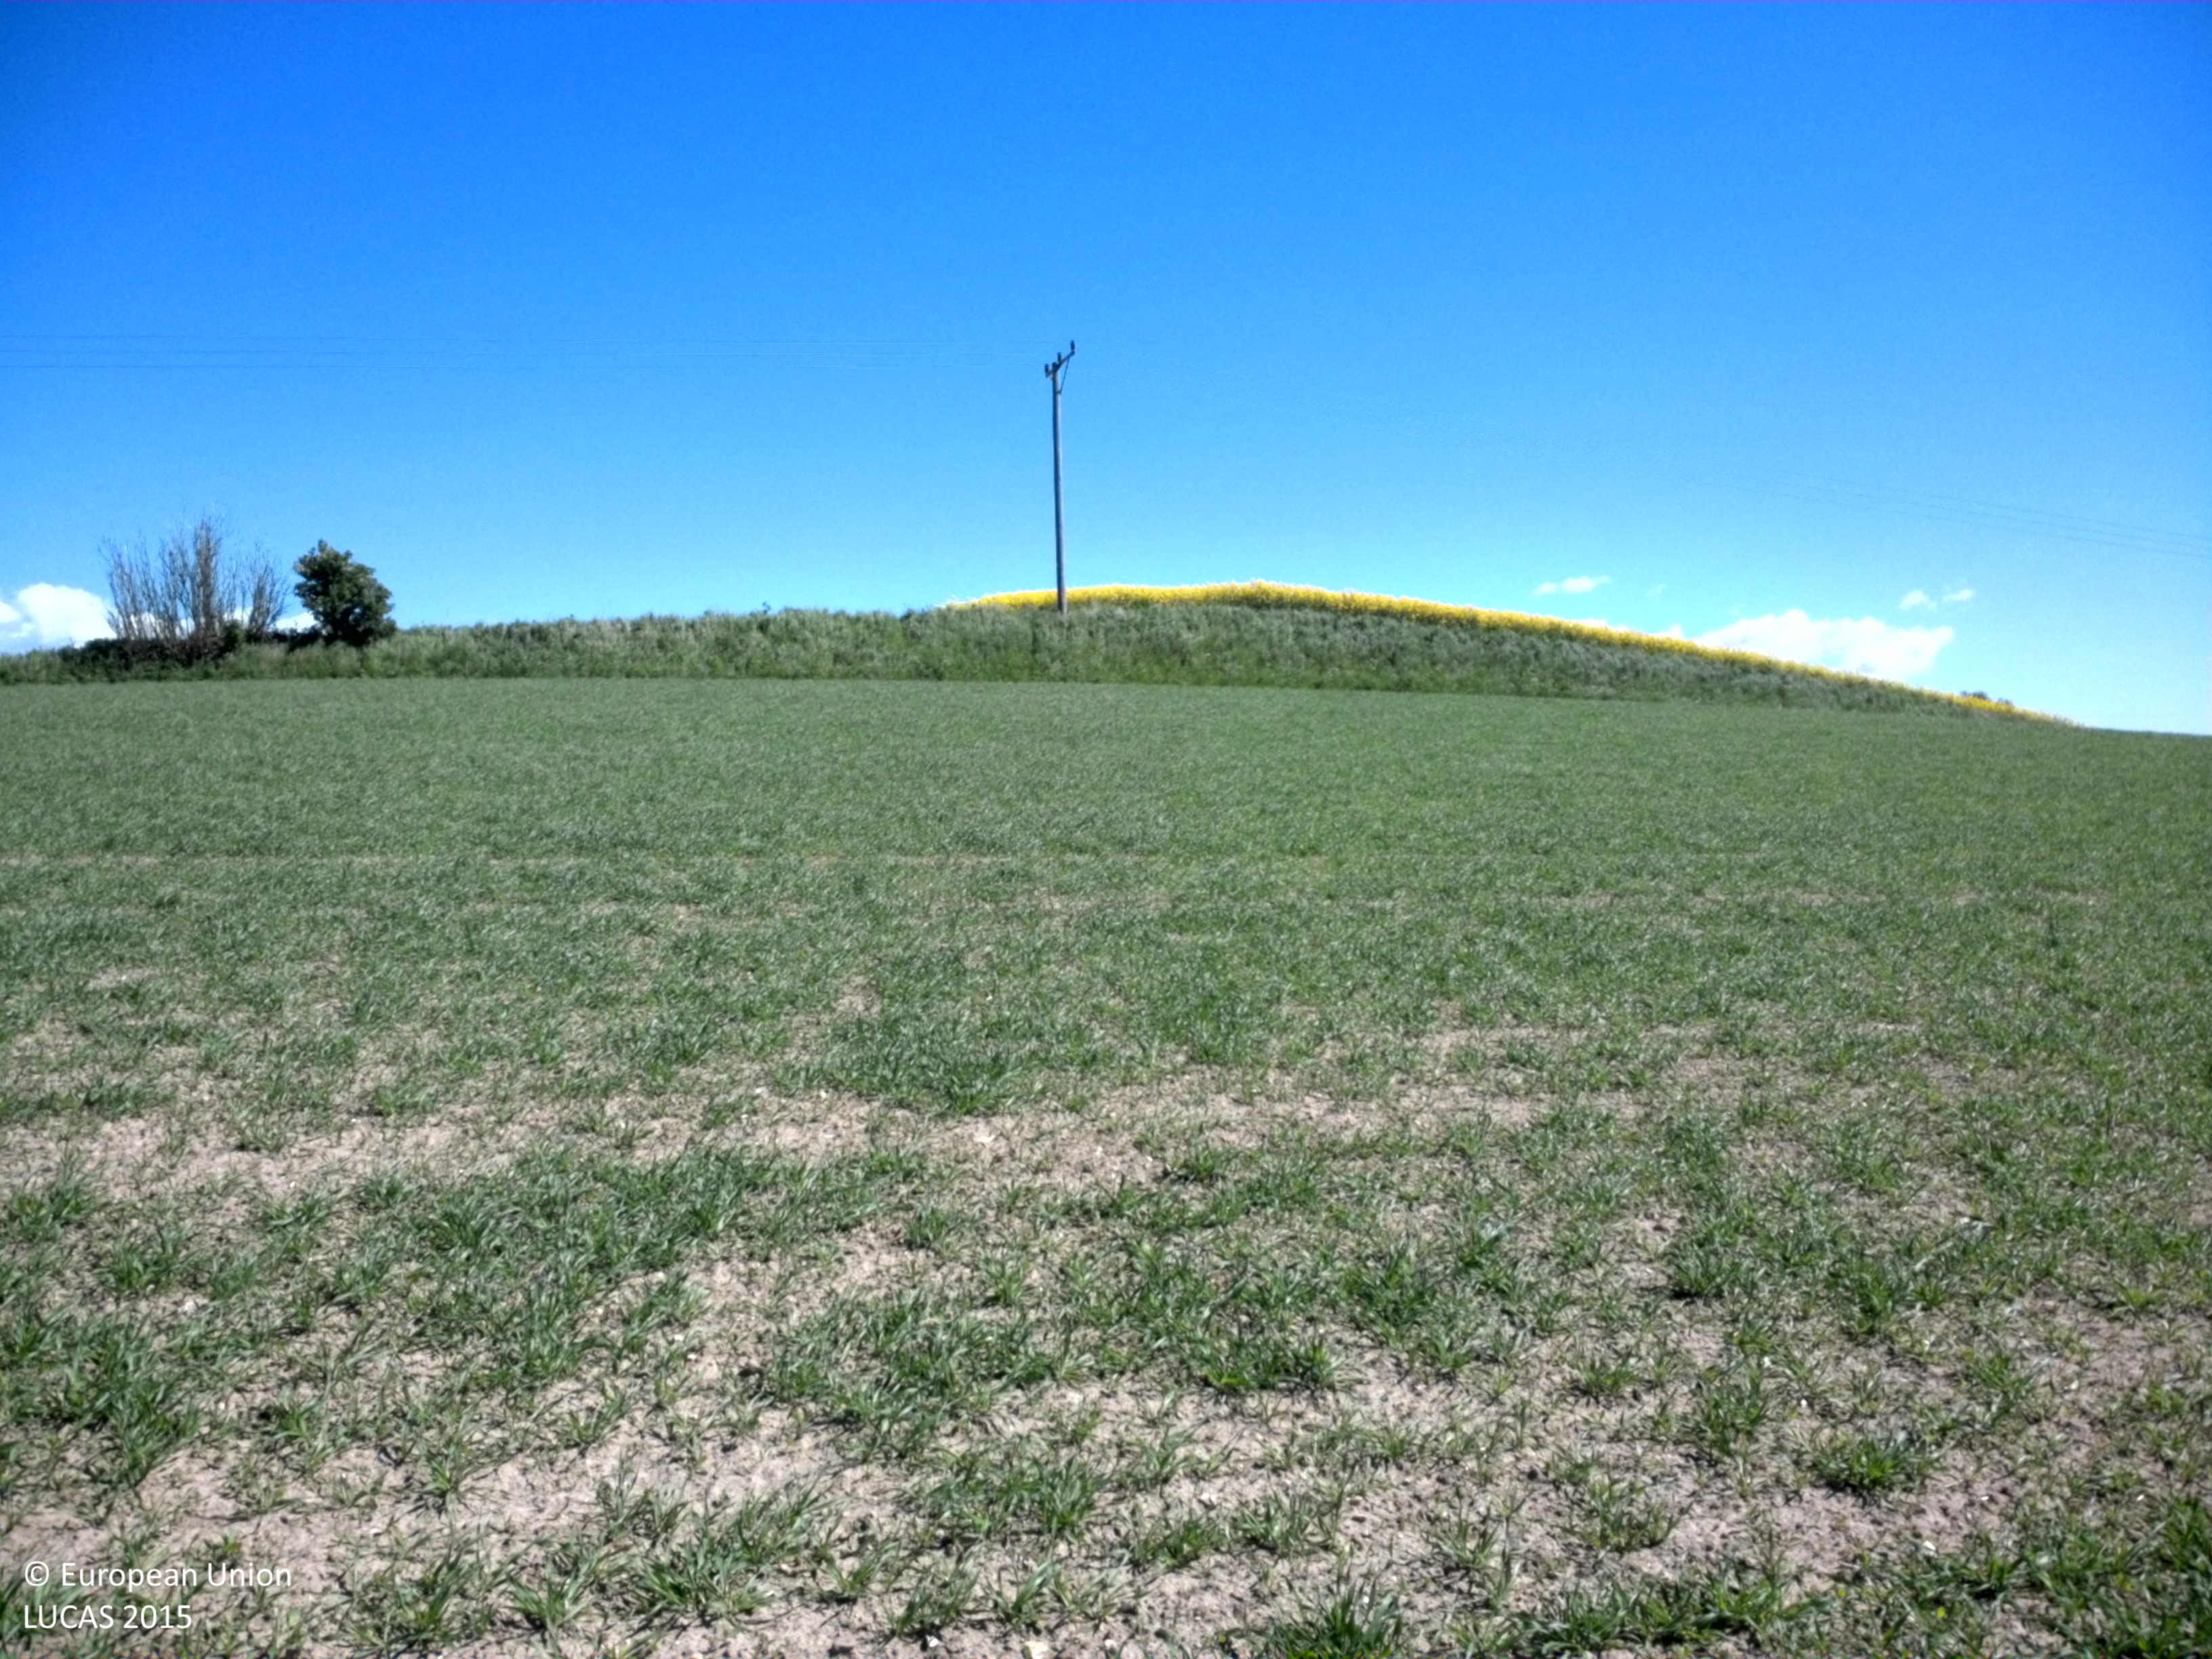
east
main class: Cropland
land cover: Barley
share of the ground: 50 - 75 %
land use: Agriculture (excluding fallow land and kitchen gardens)
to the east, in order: Barley; Grass margins; Electric lines; Rape and turnip rape; Broadleaved woodland
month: May
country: SE
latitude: 55.5023
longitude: 13.1169
